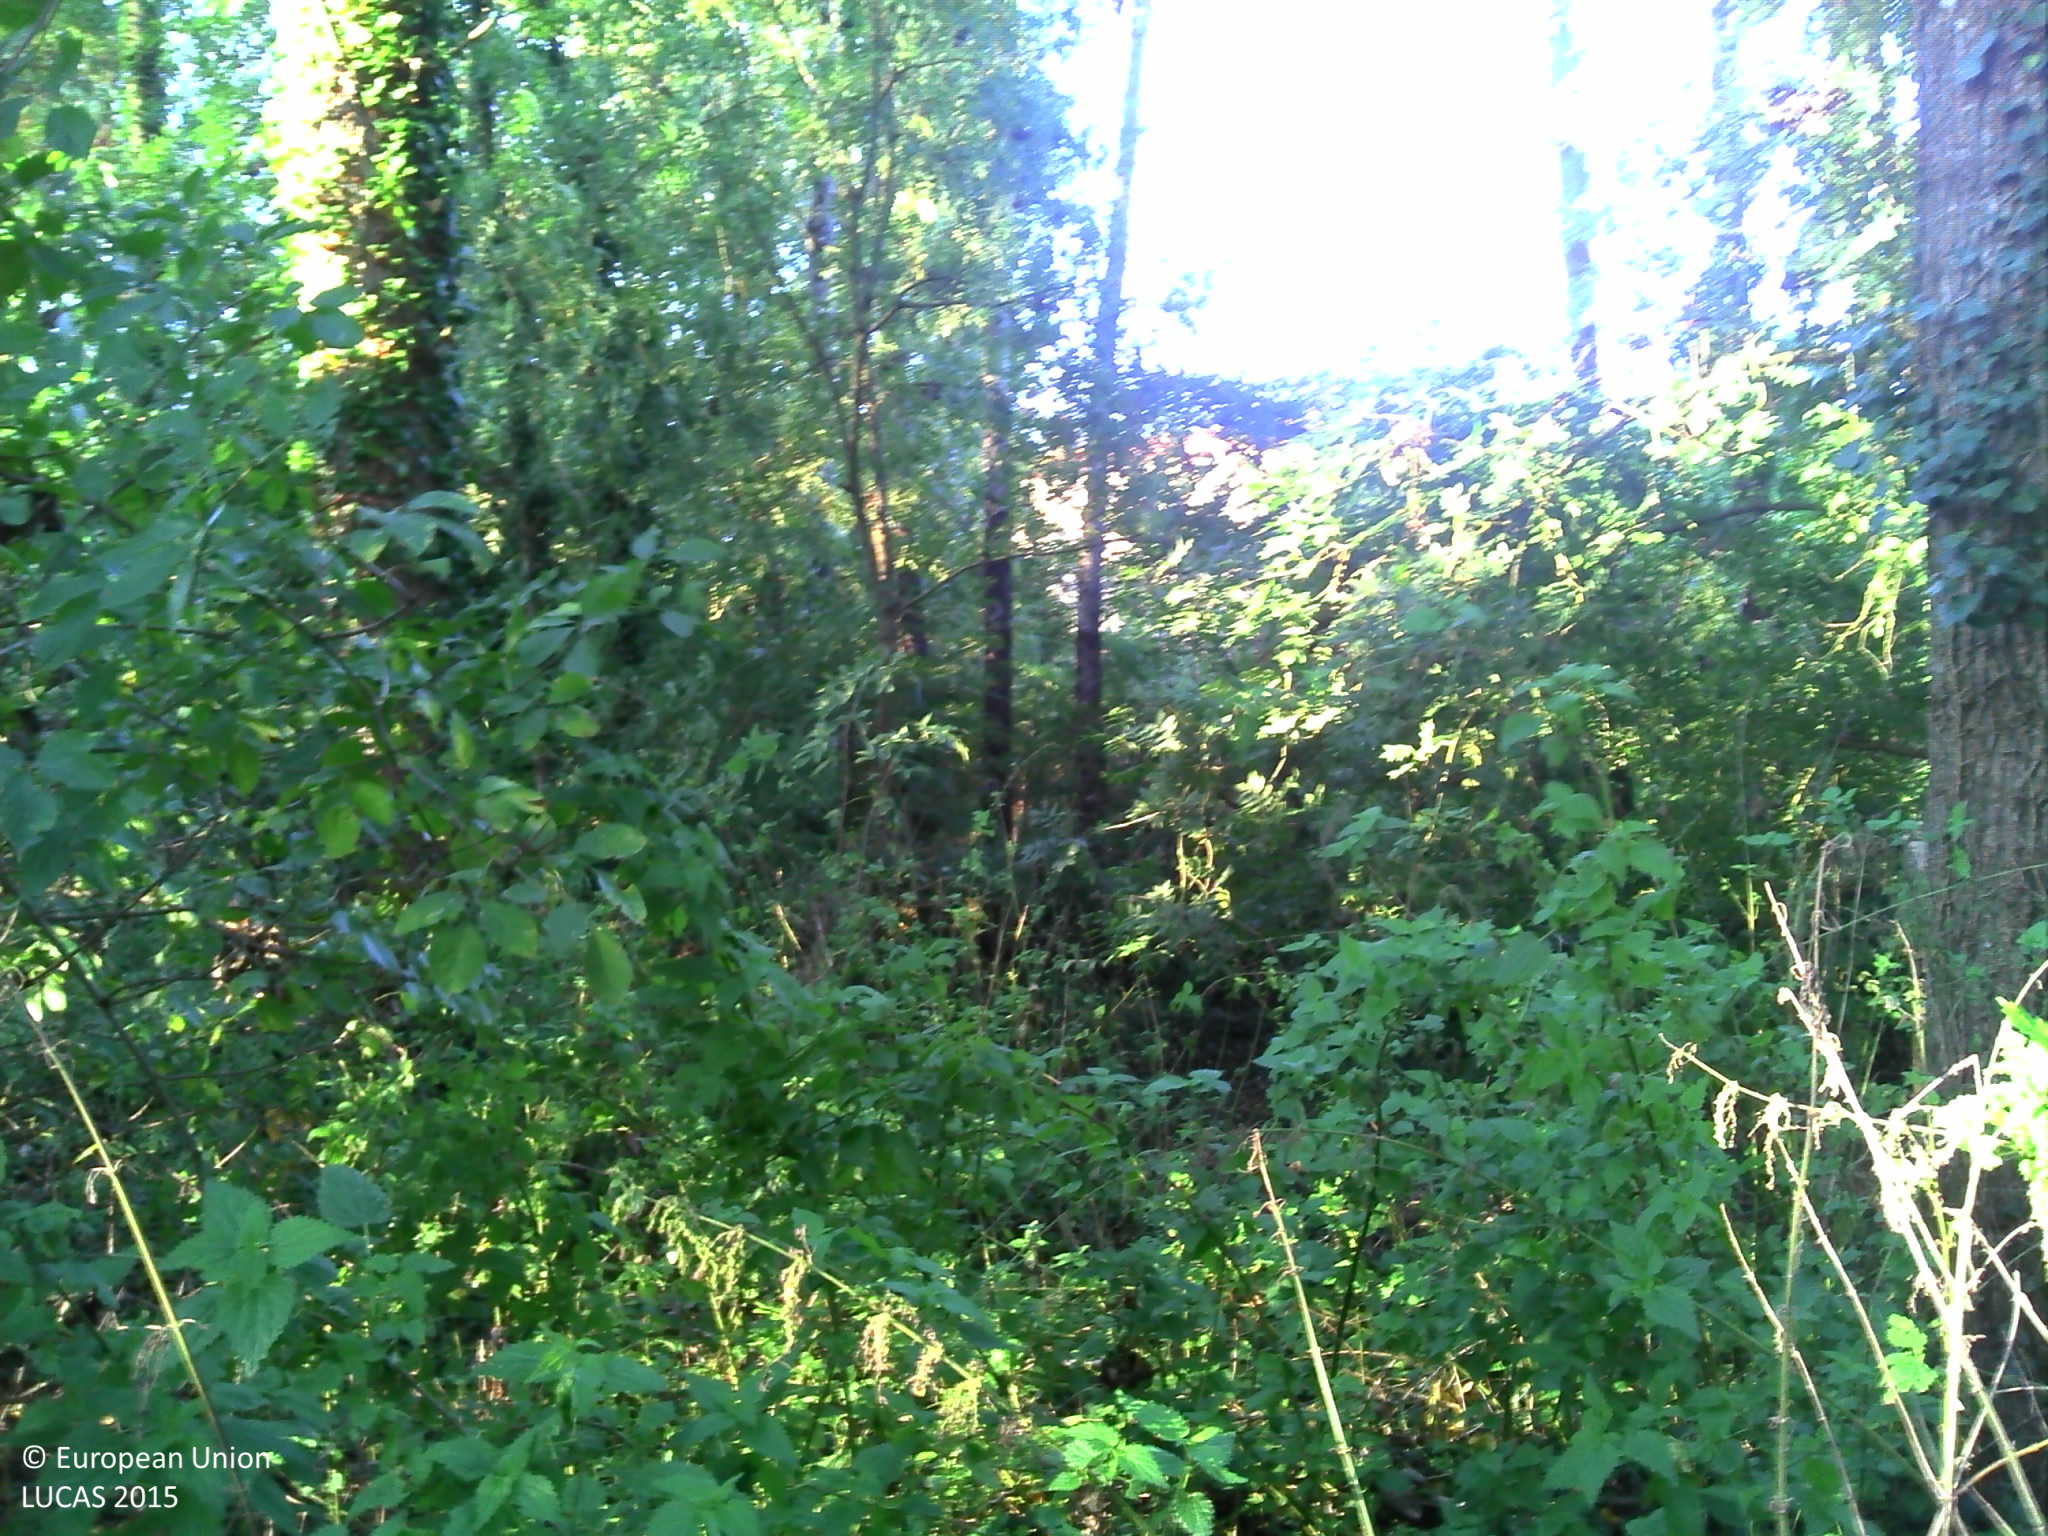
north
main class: Woodland
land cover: Broadleaved woodland
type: floodplain forest
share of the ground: 50 - 75 %
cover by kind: broadleaved forest trees 70 %, herbaceous plants 30 %
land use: Semi-natural and natural areas not in use
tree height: > 5 m
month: September
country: FR
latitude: 46.5879
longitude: -1.1141
